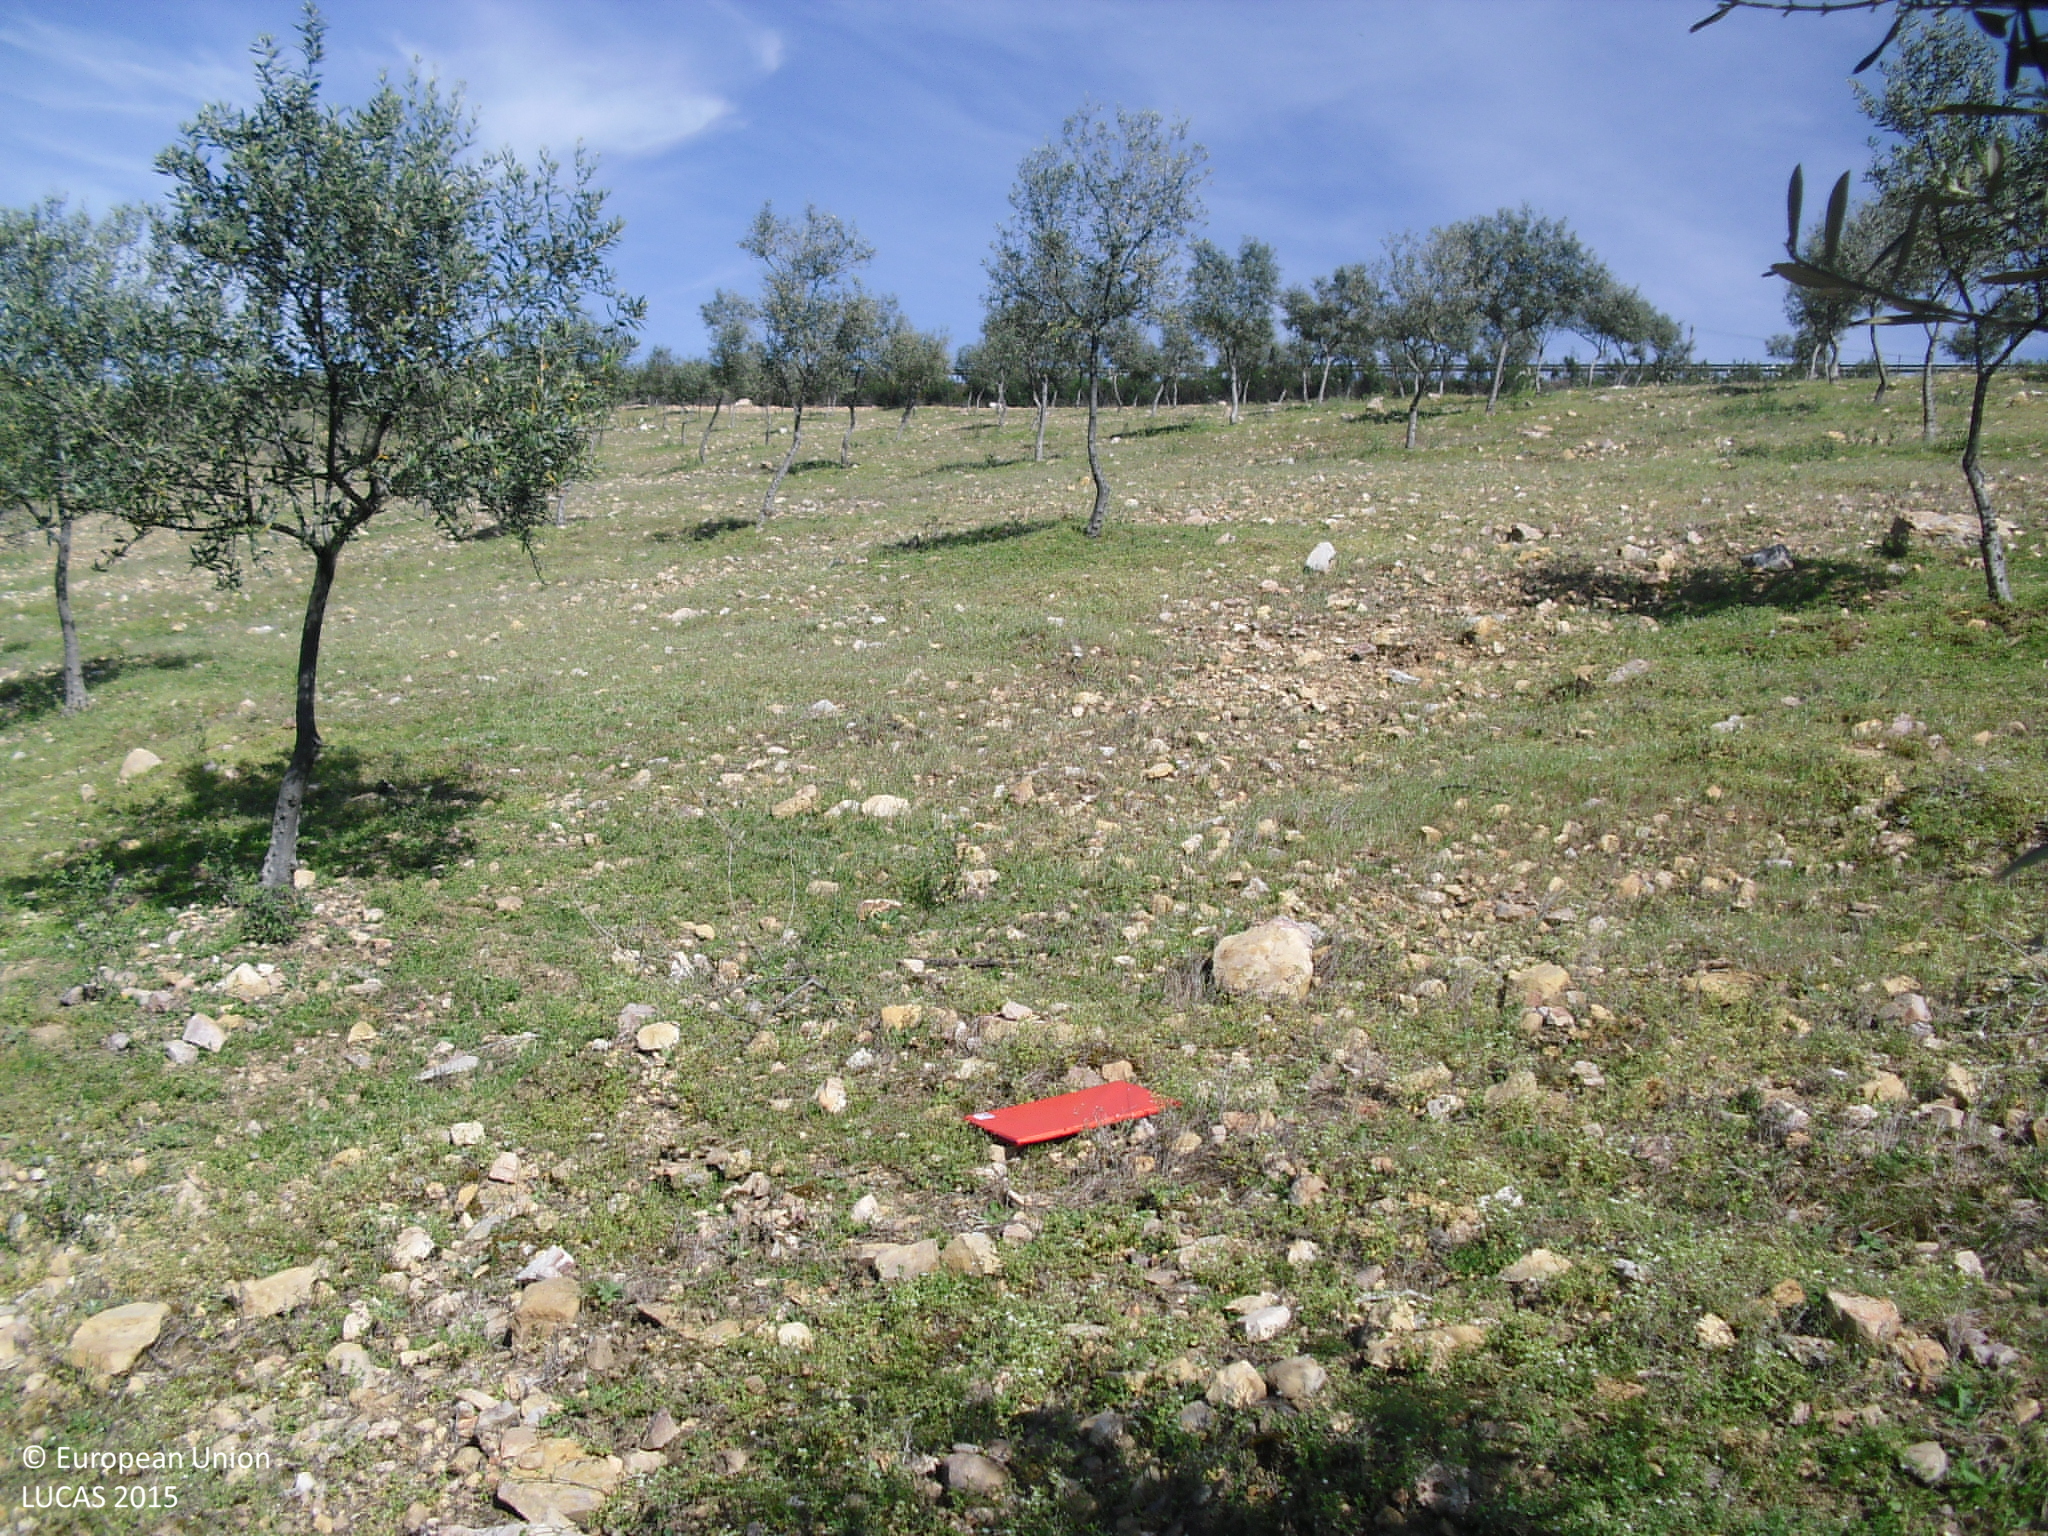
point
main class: Cropland
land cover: Olive groves
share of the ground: 10 - 25 %
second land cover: Spontaneously vegetated surfaces
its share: > 75 %
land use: Agriculture (excluding fallow land and kitchen gardens)
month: April
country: ES
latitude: 39.3665
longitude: -5.3330
